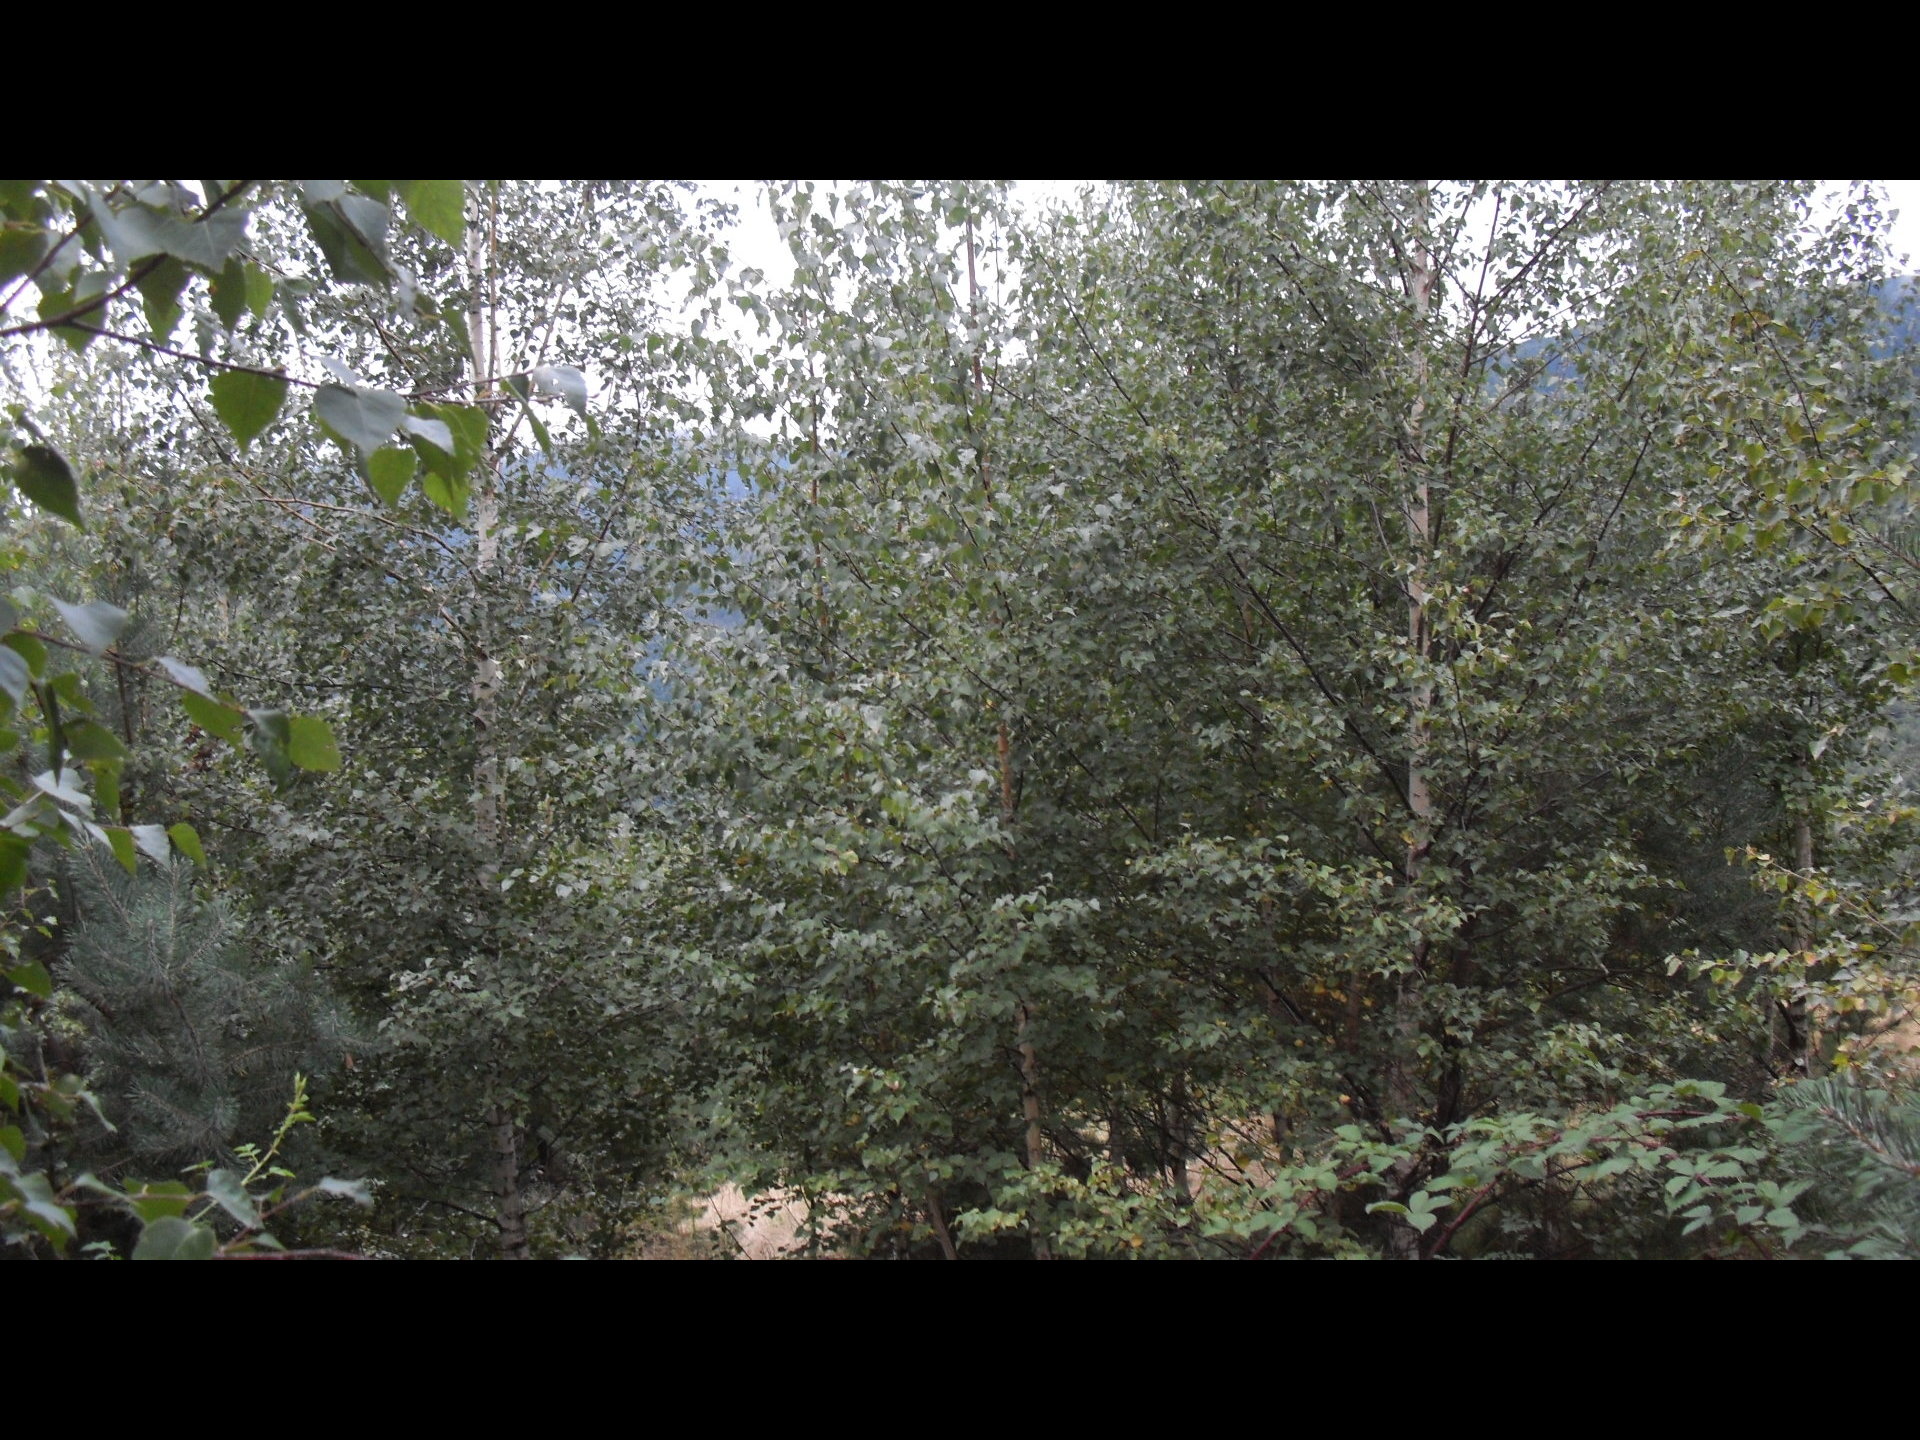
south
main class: Woodland
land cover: Broadleaved woodland
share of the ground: > 75 %
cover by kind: broadleaved forest trees 85 %, coniferous forest trees 10 %, shrubs 5 %
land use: Semi-natural and natural areas not in use
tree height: < 5 m
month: October
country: BG
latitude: 43.3887
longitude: 22.8104
